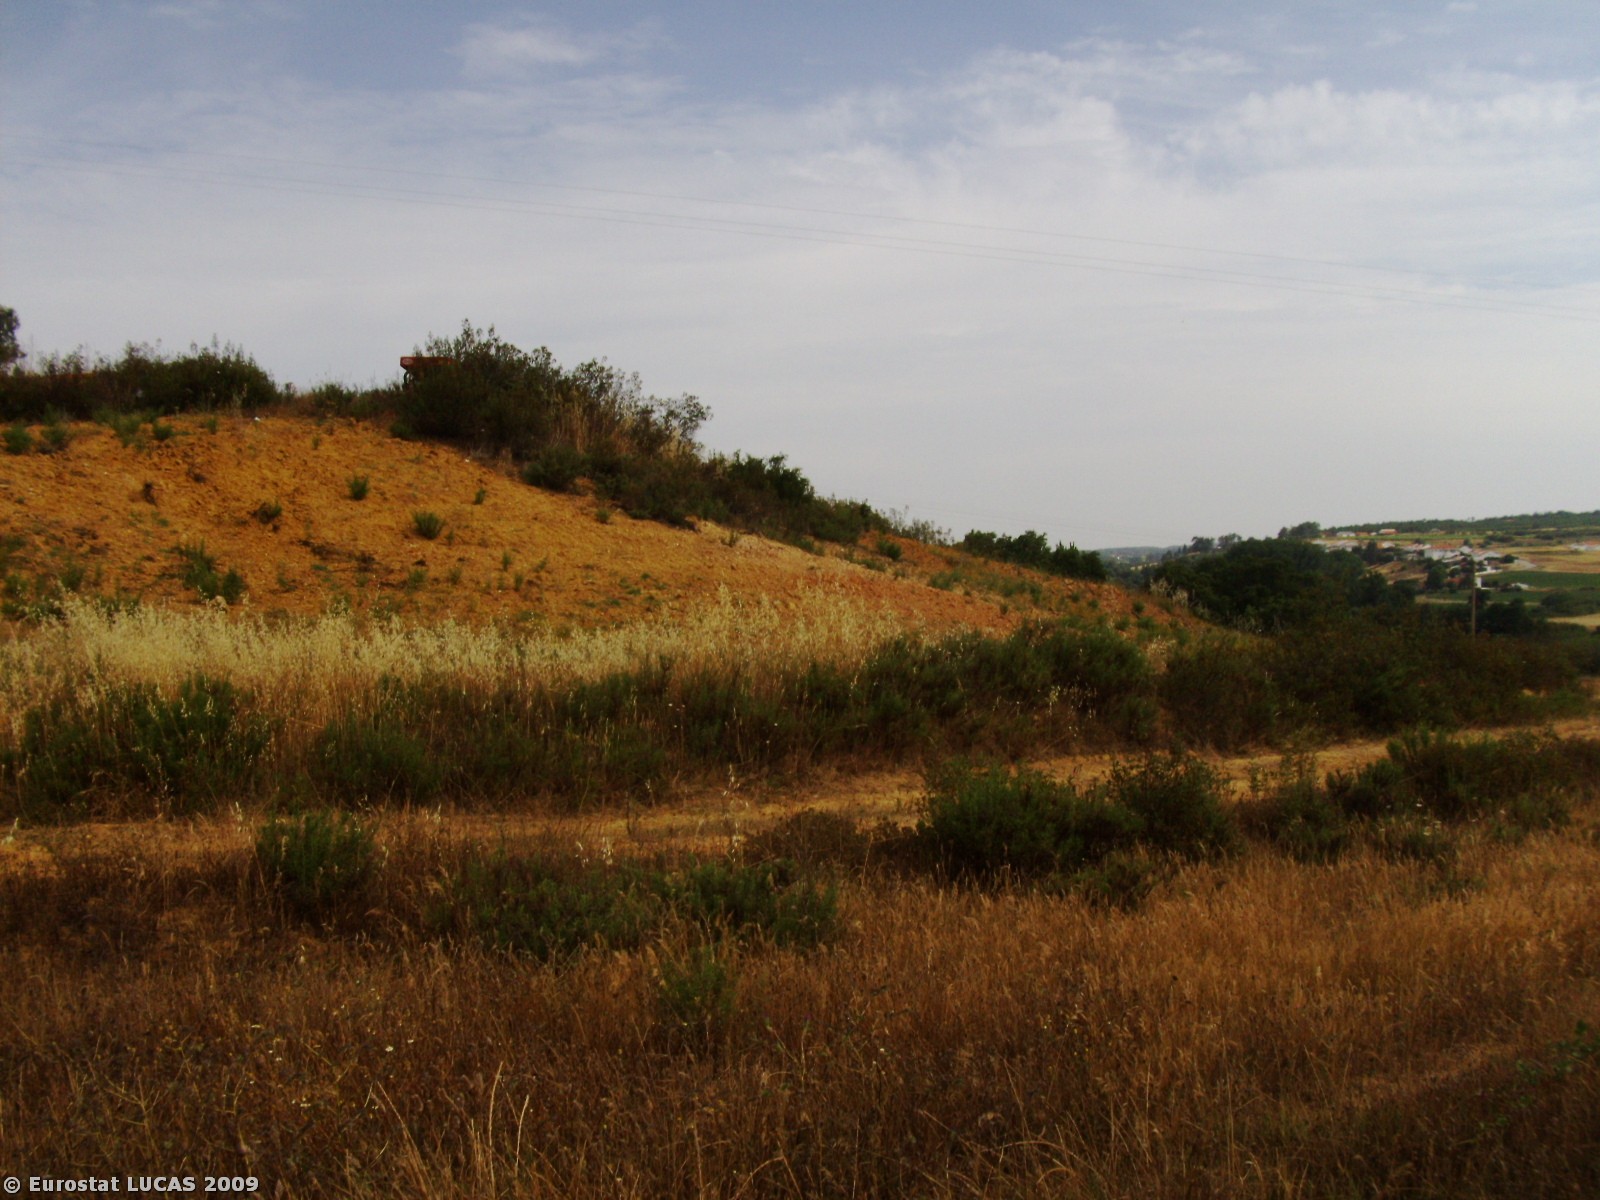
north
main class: Grassland
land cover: Spontaneously vegetated surfaces
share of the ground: > 75 %
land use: Fallow land
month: June
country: PT
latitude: 37.3411
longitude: -8.7850
